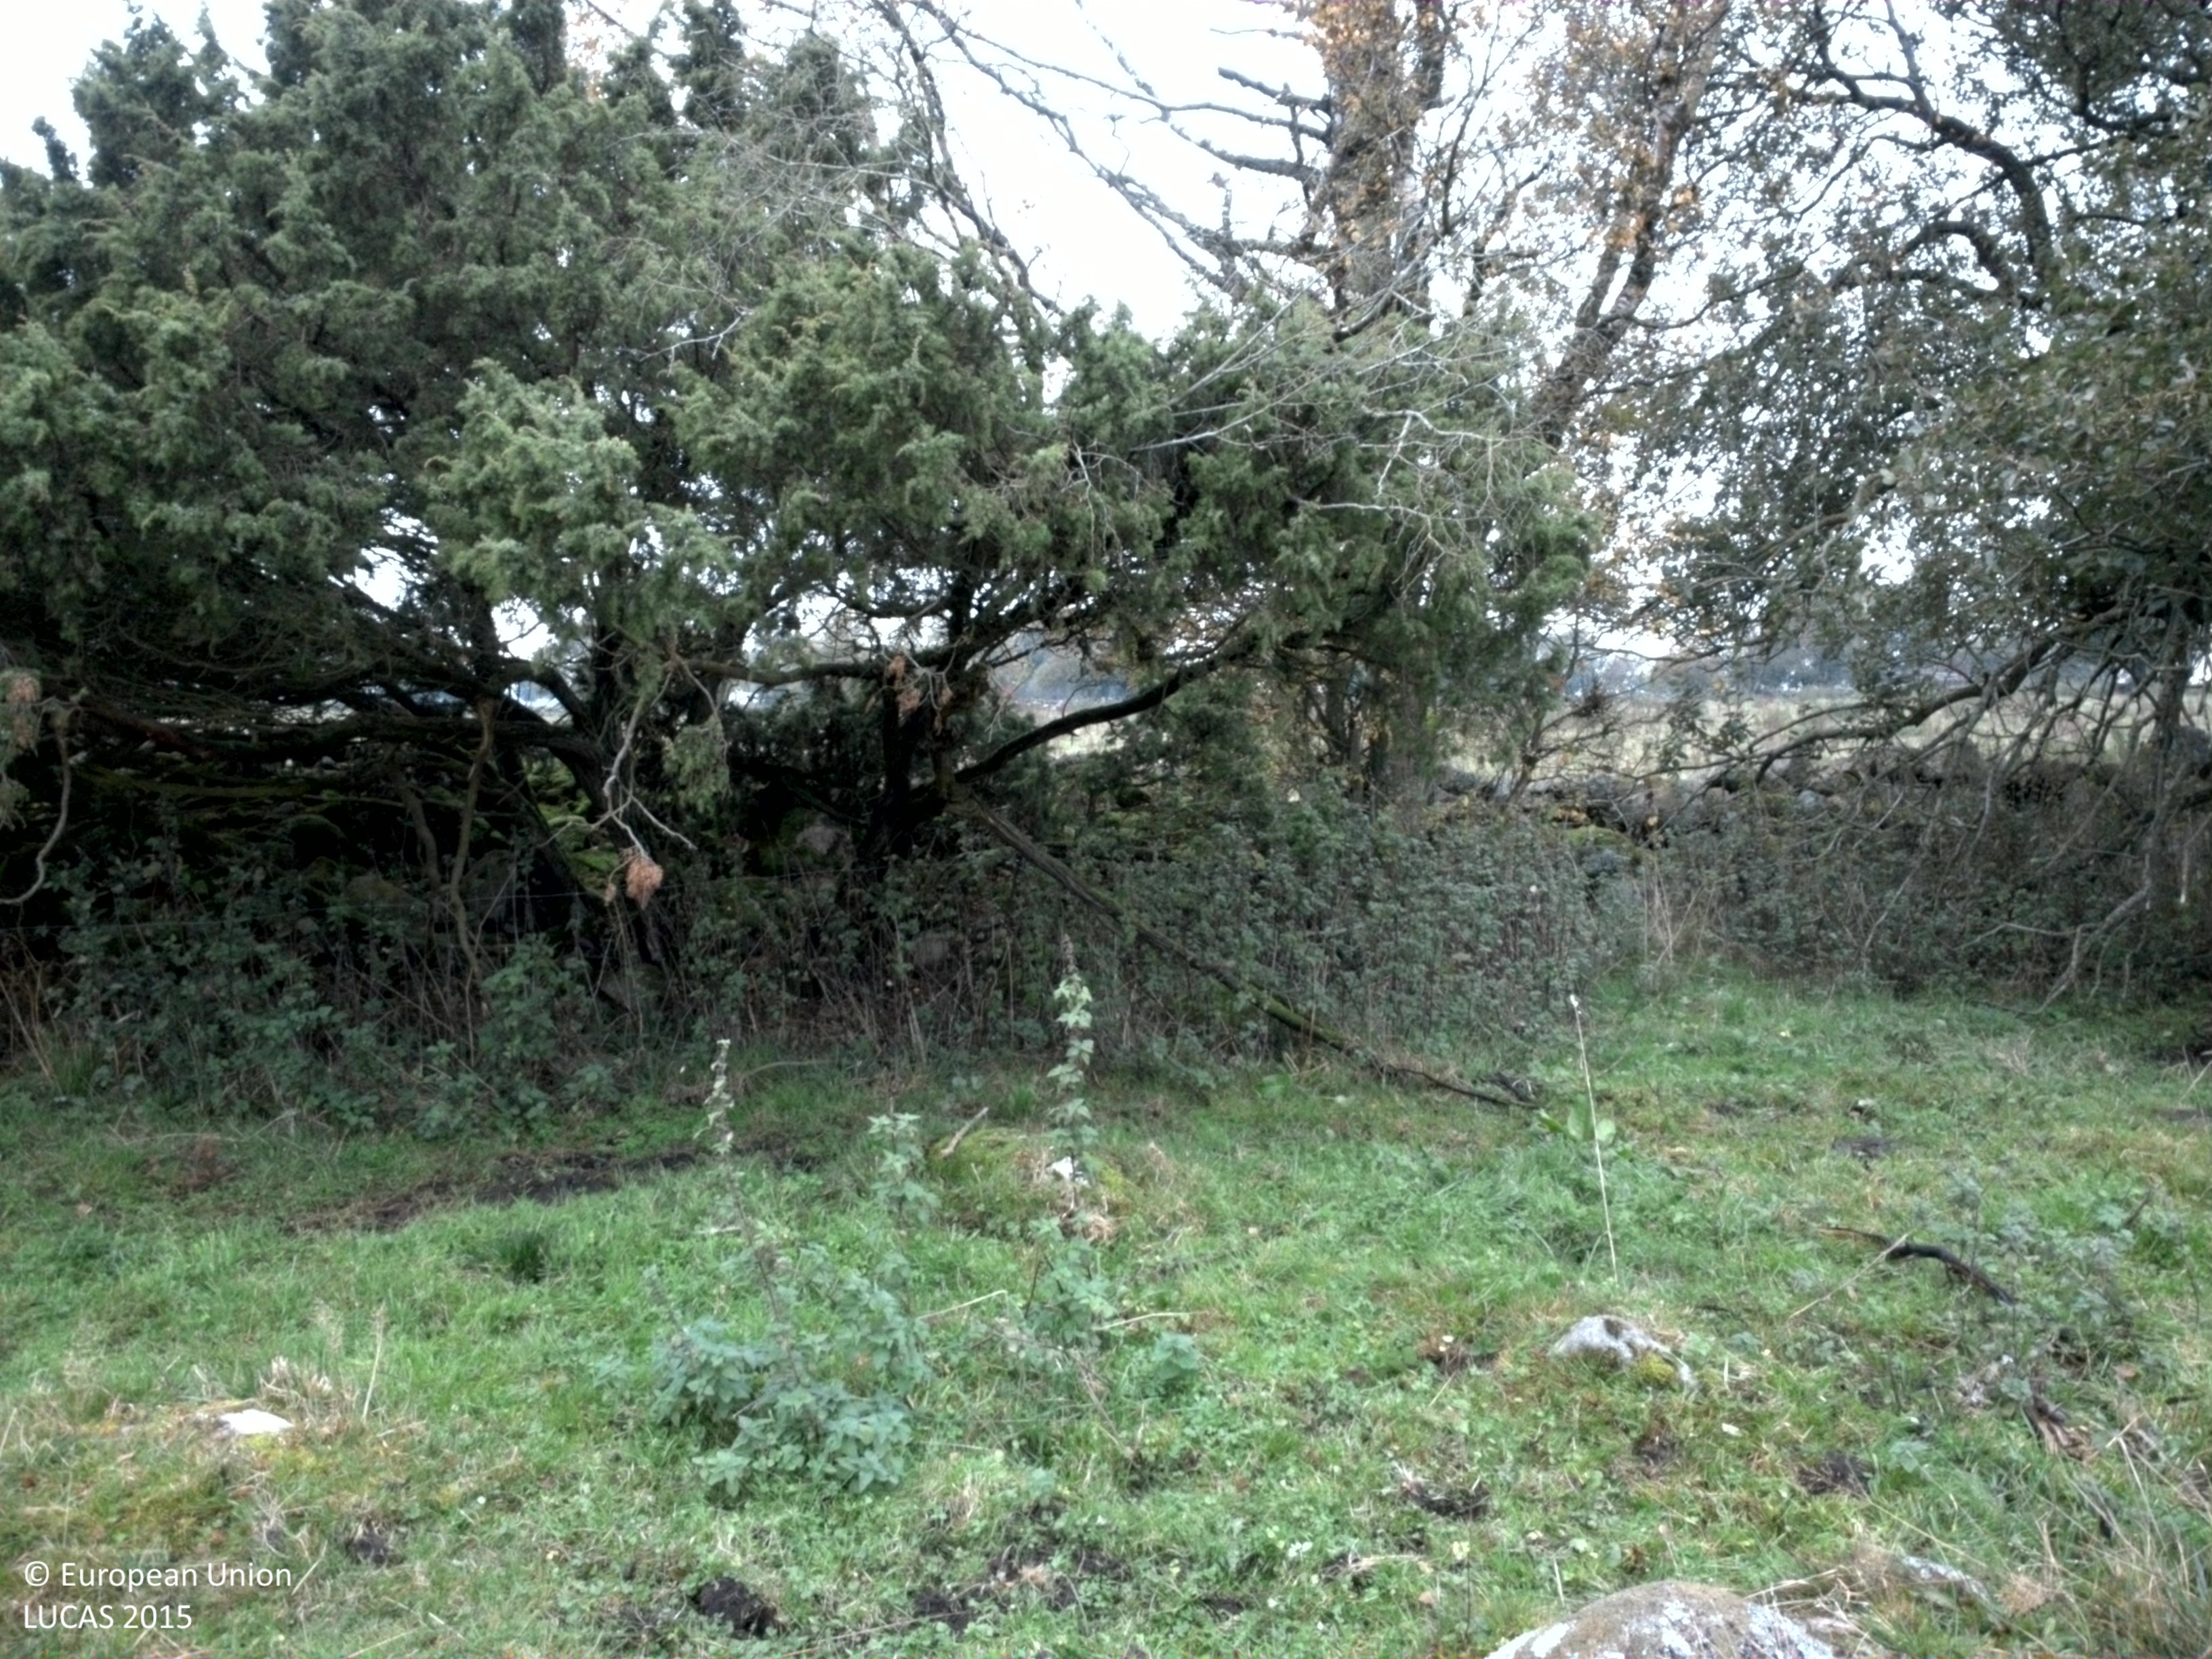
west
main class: Grassland
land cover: Grassland without tree/shrub cover
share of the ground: > 75 %
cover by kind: herbaceous plants 100 %
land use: Agriculture (excluding fallow land and kitchen gardens)
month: October
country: SE
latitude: 55.8101
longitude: 13.7158
